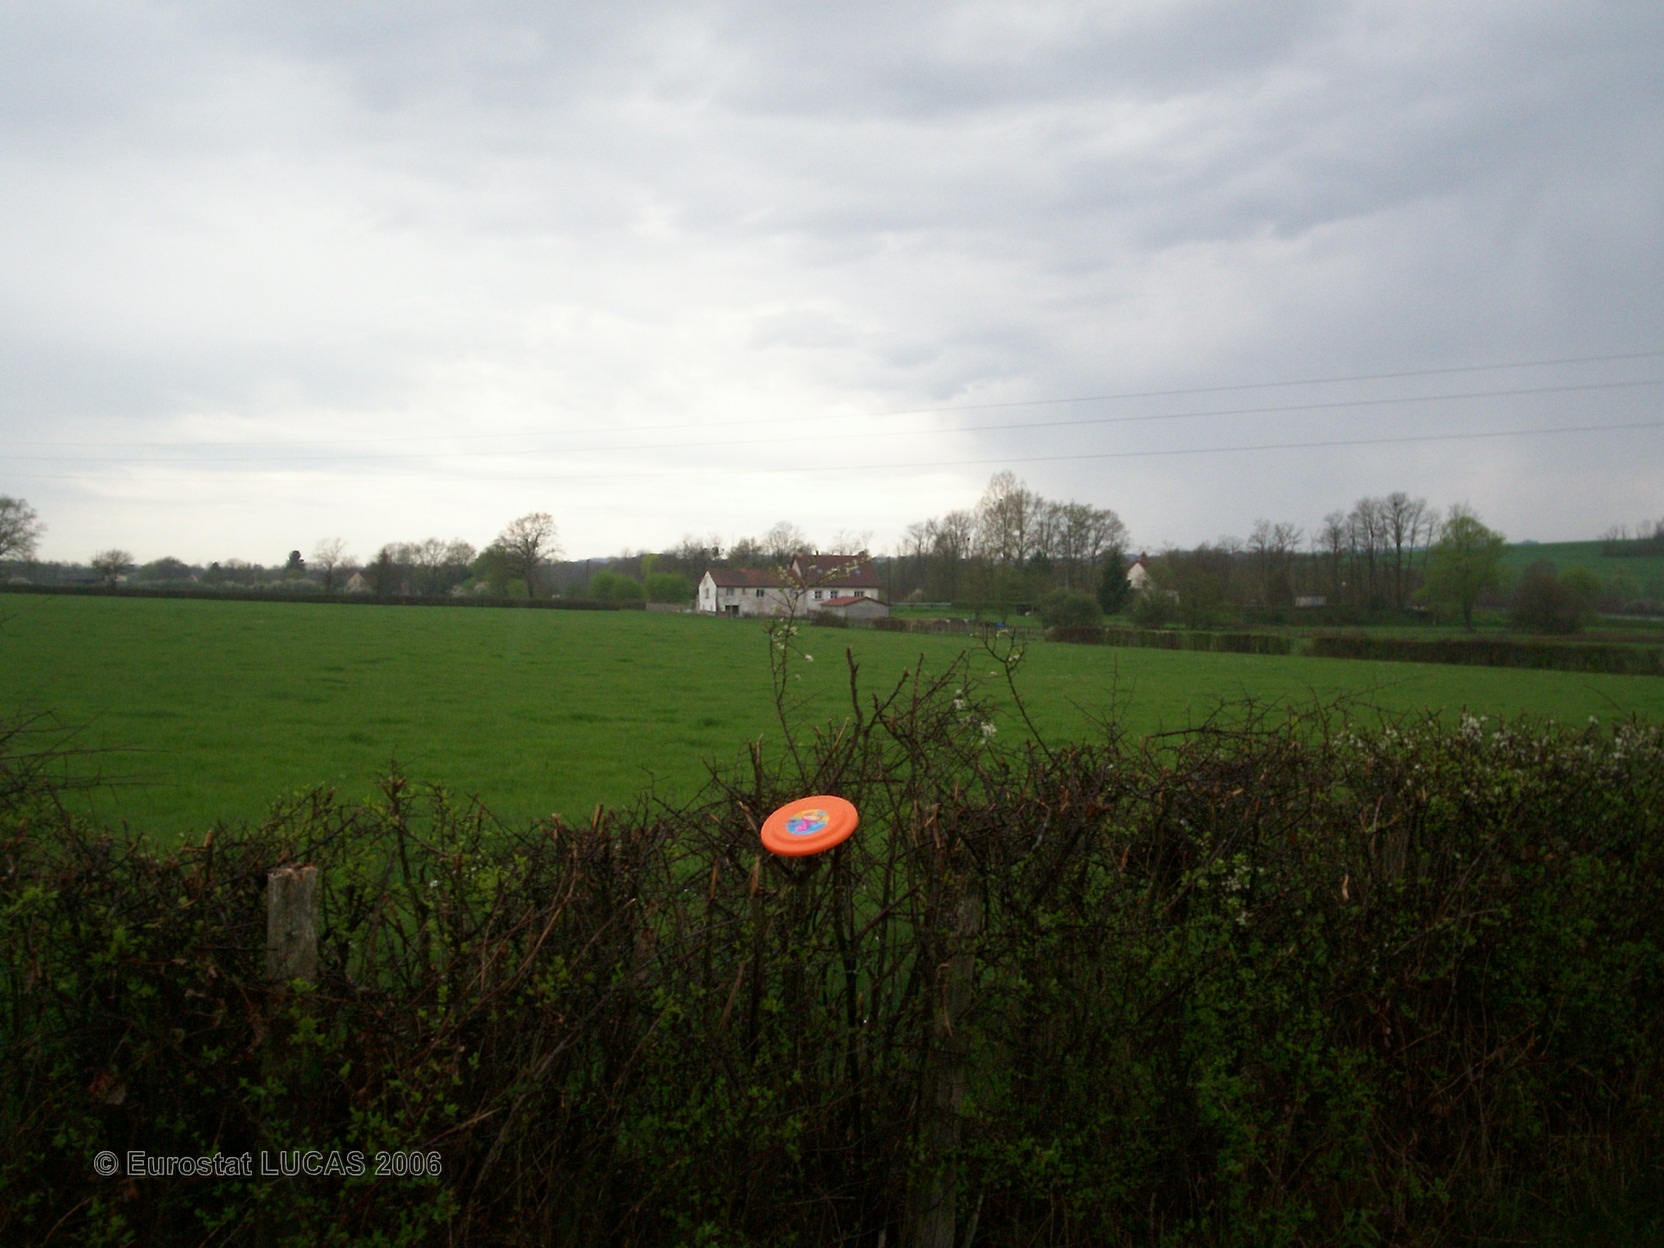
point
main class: Grassland
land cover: Grassland without tree/shrub cover
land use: Agriculture (excluding fallow land and kitchen gardens)
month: April
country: FR
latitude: 46.8291
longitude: 4.6128
